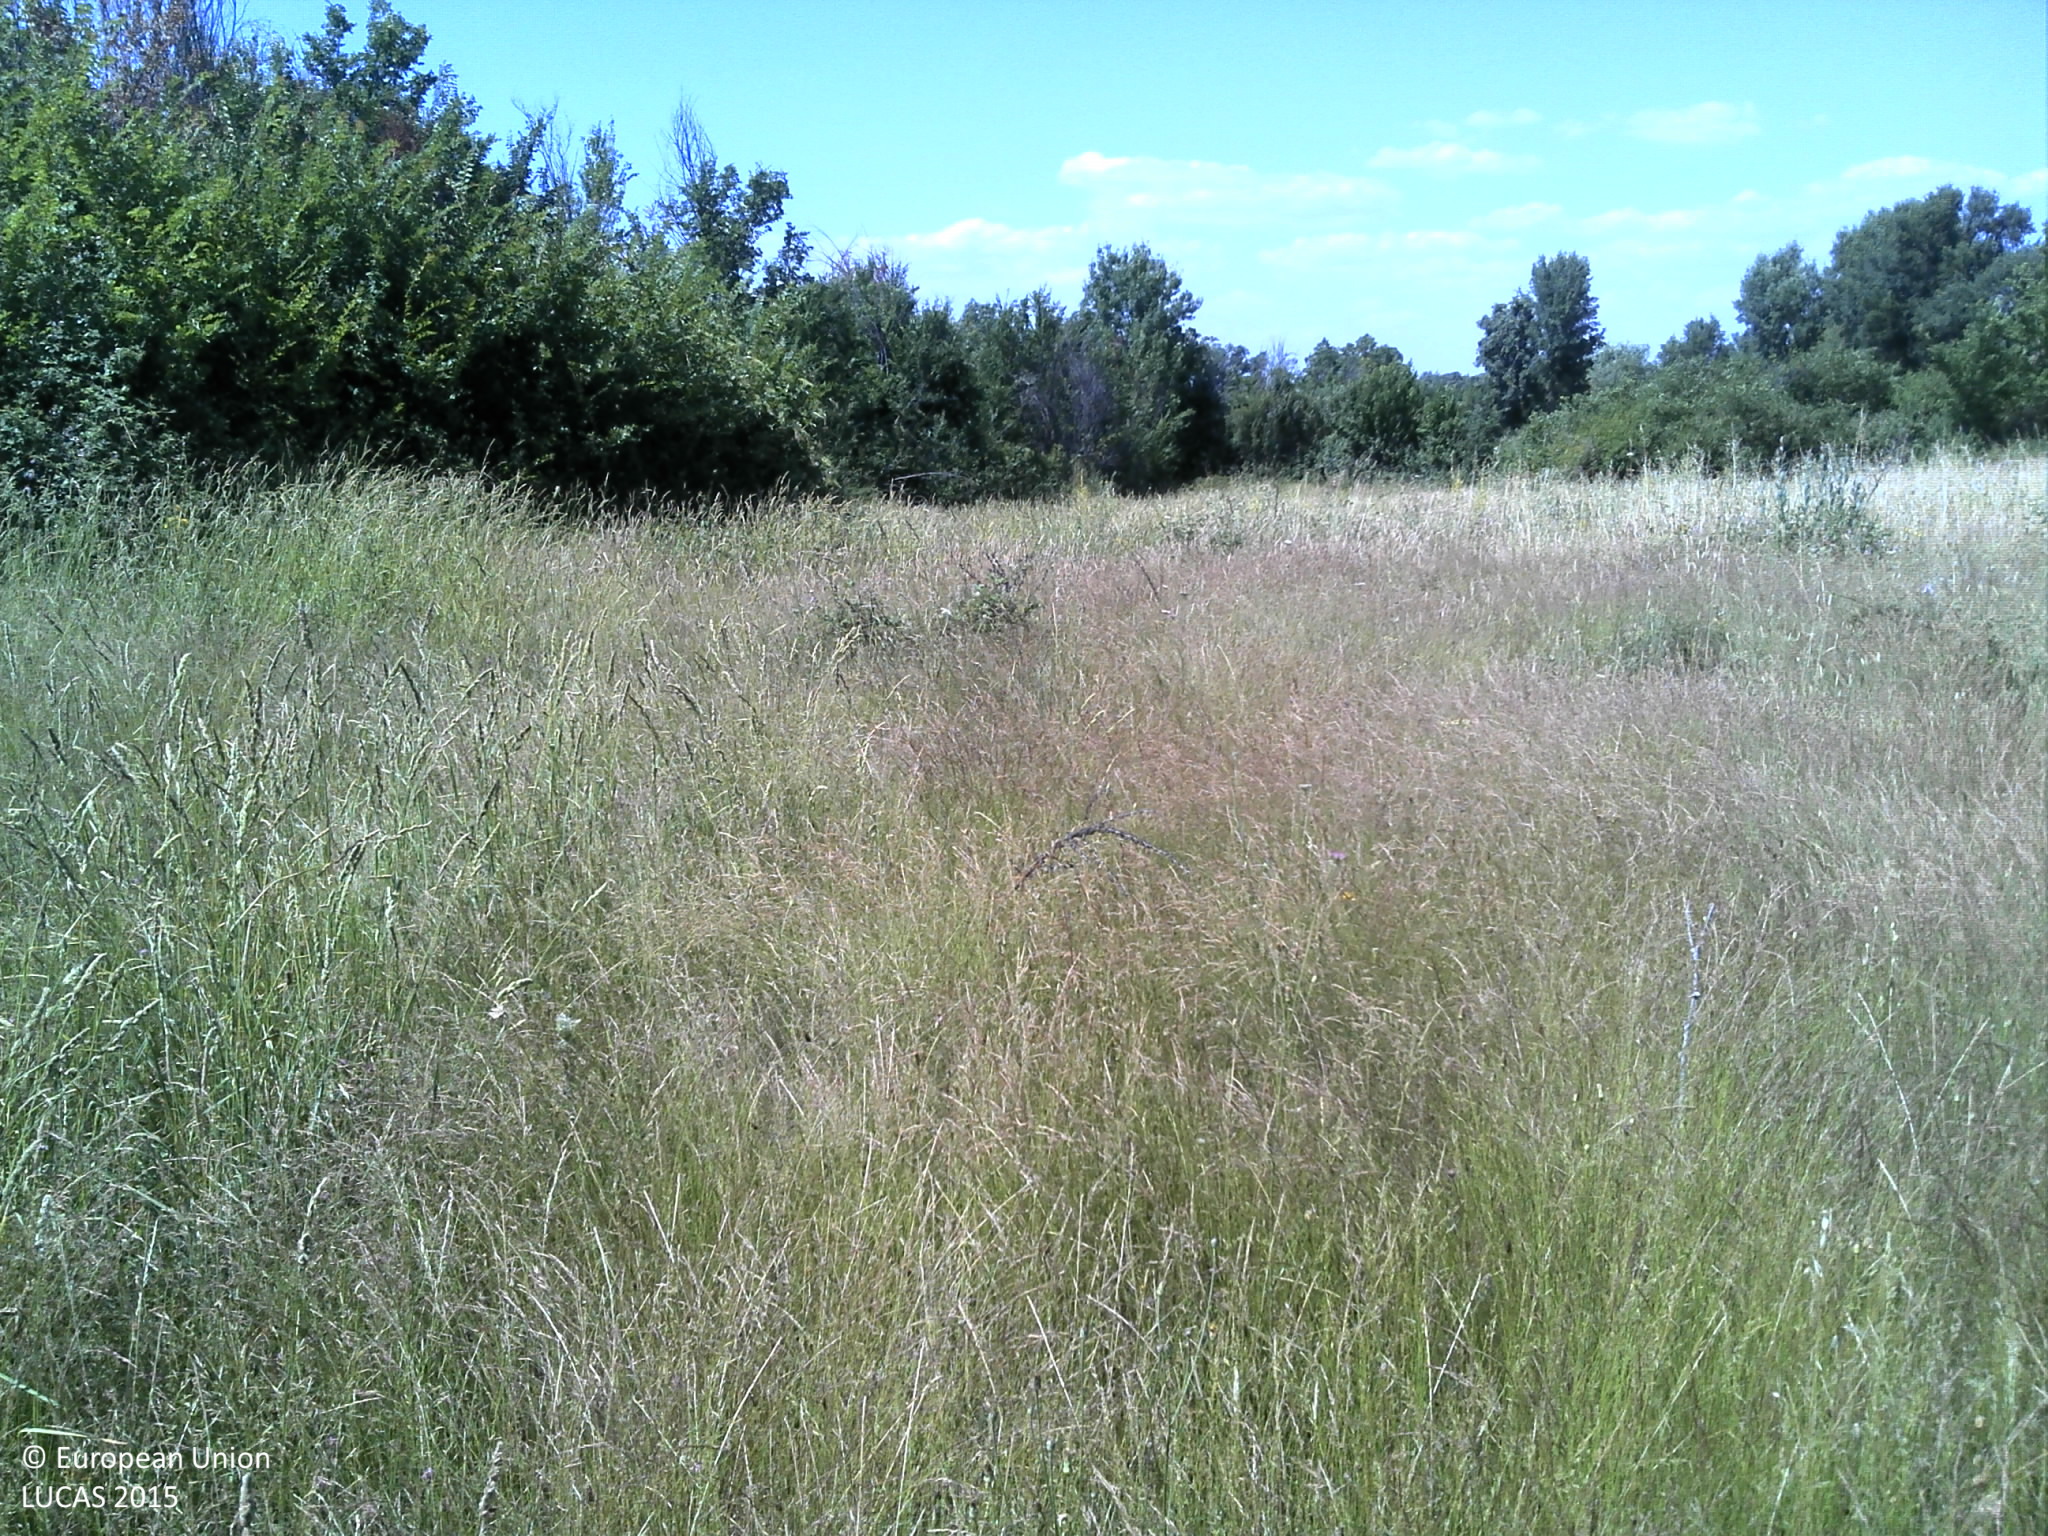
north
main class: Grassland
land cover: Grassland without tree/shrub cover
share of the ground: > 75 %
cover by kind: herbaceous plants 100 %
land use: Agriculture (excluding fallow land and kitchen gardens)
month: June
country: PT
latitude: 40.8691
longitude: -6.9156
